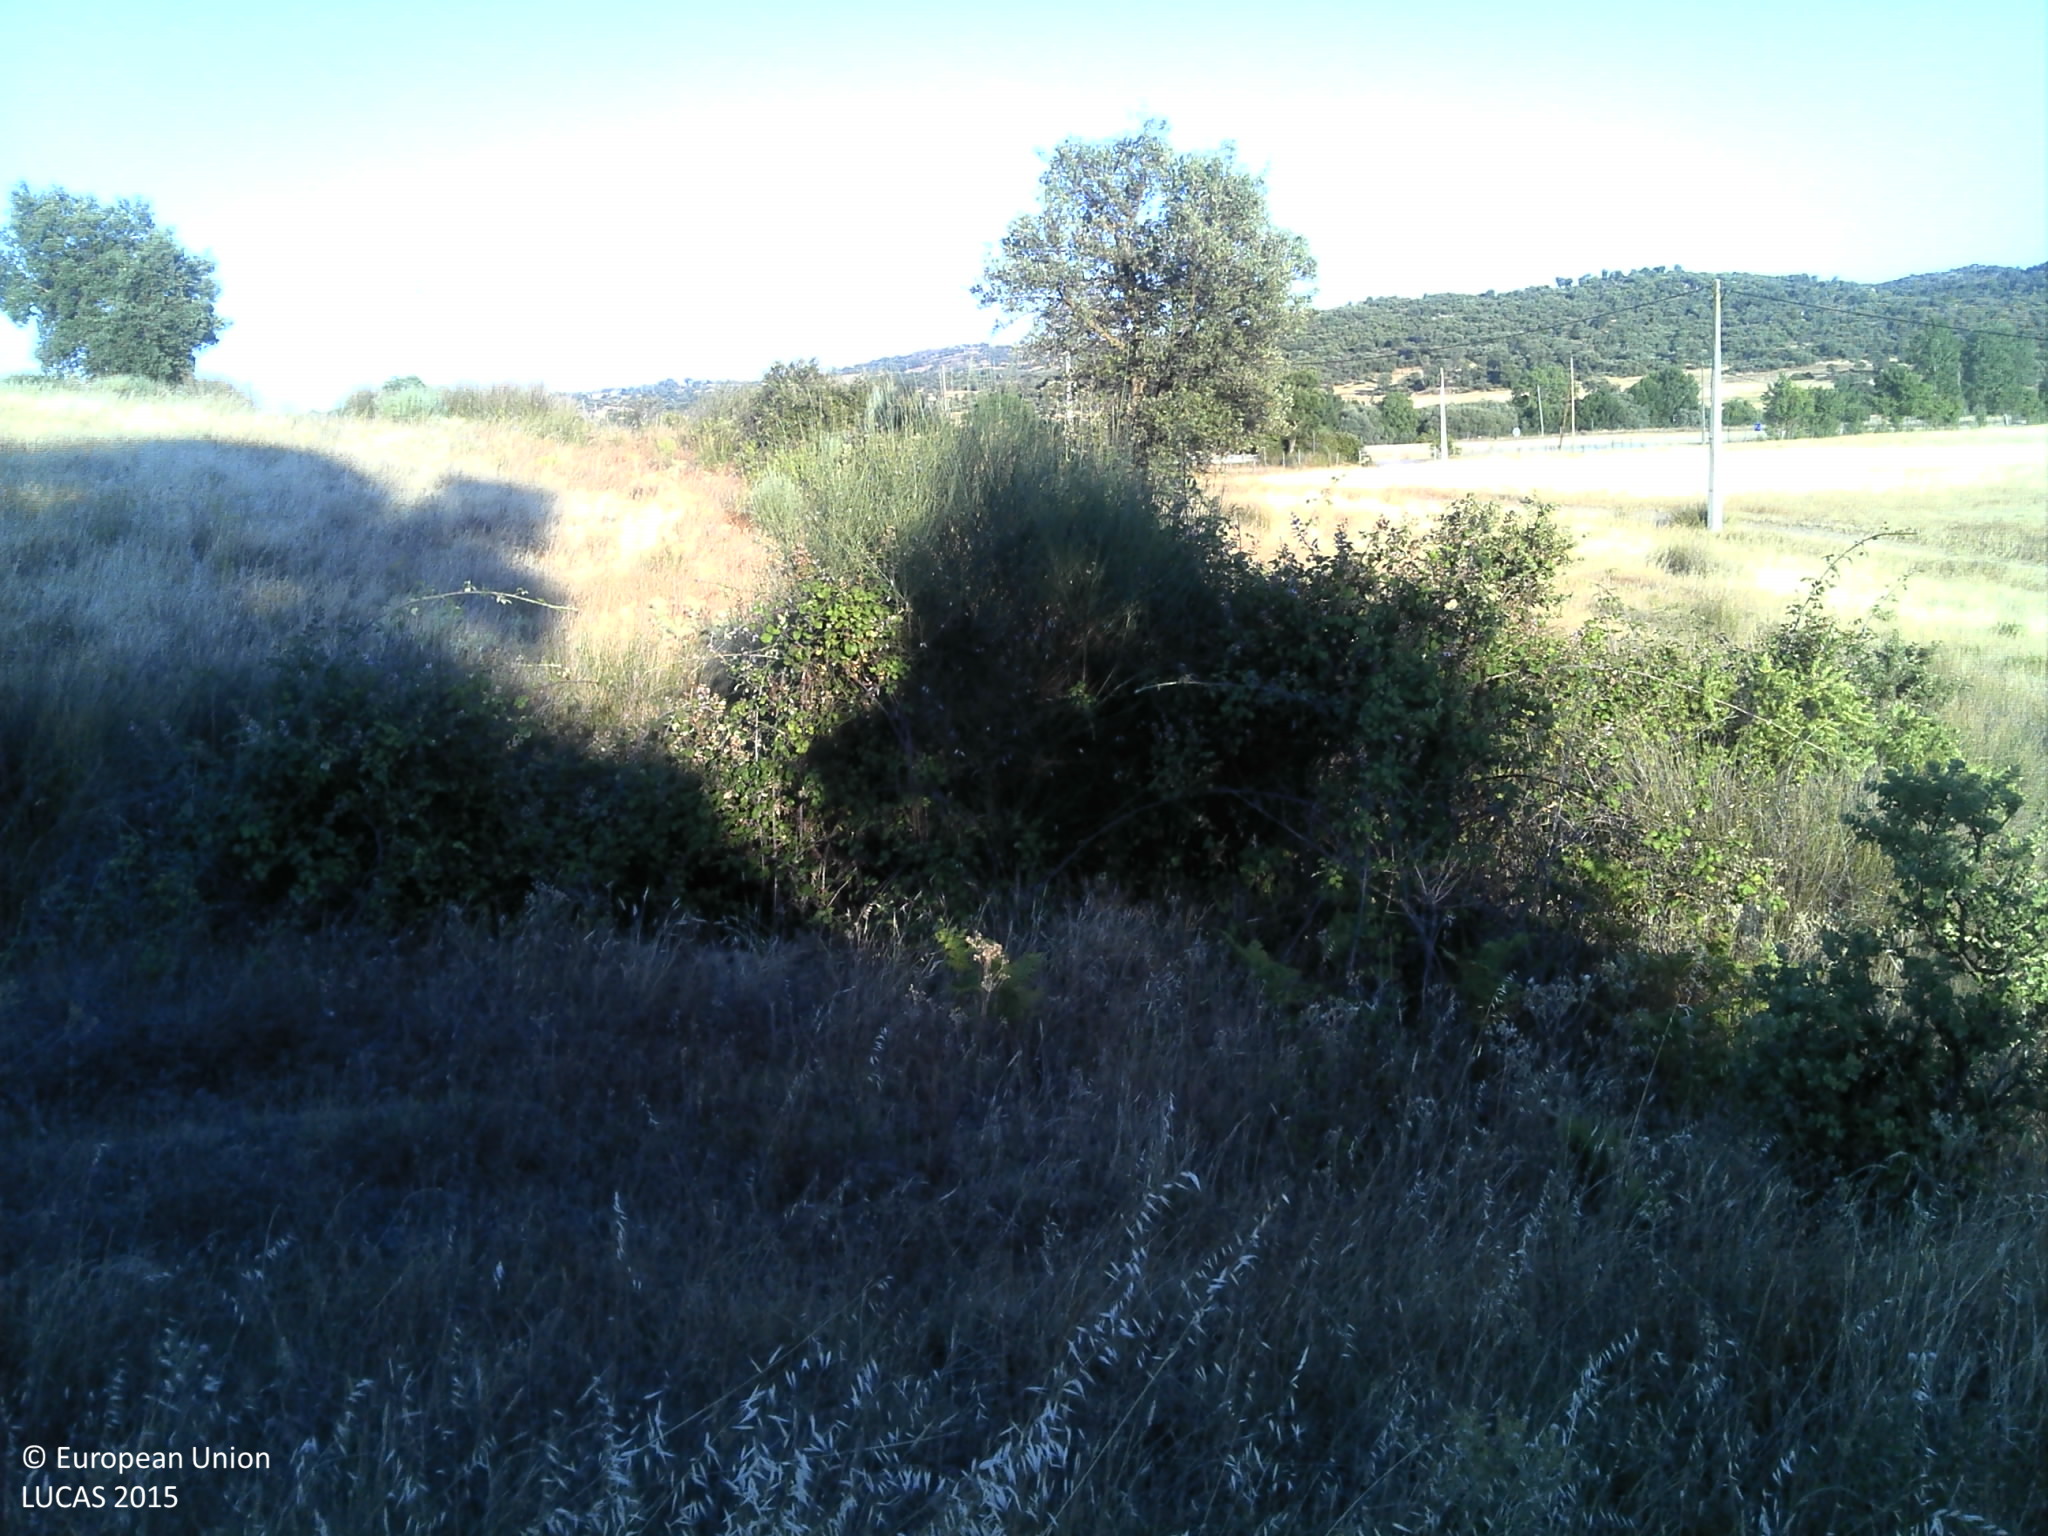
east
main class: Grassland
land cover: Grassland without tree/shrub cover
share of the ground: 50 - 75 %
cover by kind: herbaceous plants 70 %, unconsolidated bare surface 20 %, shrubs 5 %
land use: Agriculture (excluding fallow land and kitchen gardens)
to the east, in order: Grassland without tree/shrub cover; Fences; Grassland with sparse tree/shrub cover; Fences; Grass margins; Paved roads, cycling and walking lanes; Grass margins; Abandoned hedges; Fences; Spontaneously vegetated surfaces
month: June
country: PT
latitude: 39.9819
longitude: -7.3474
